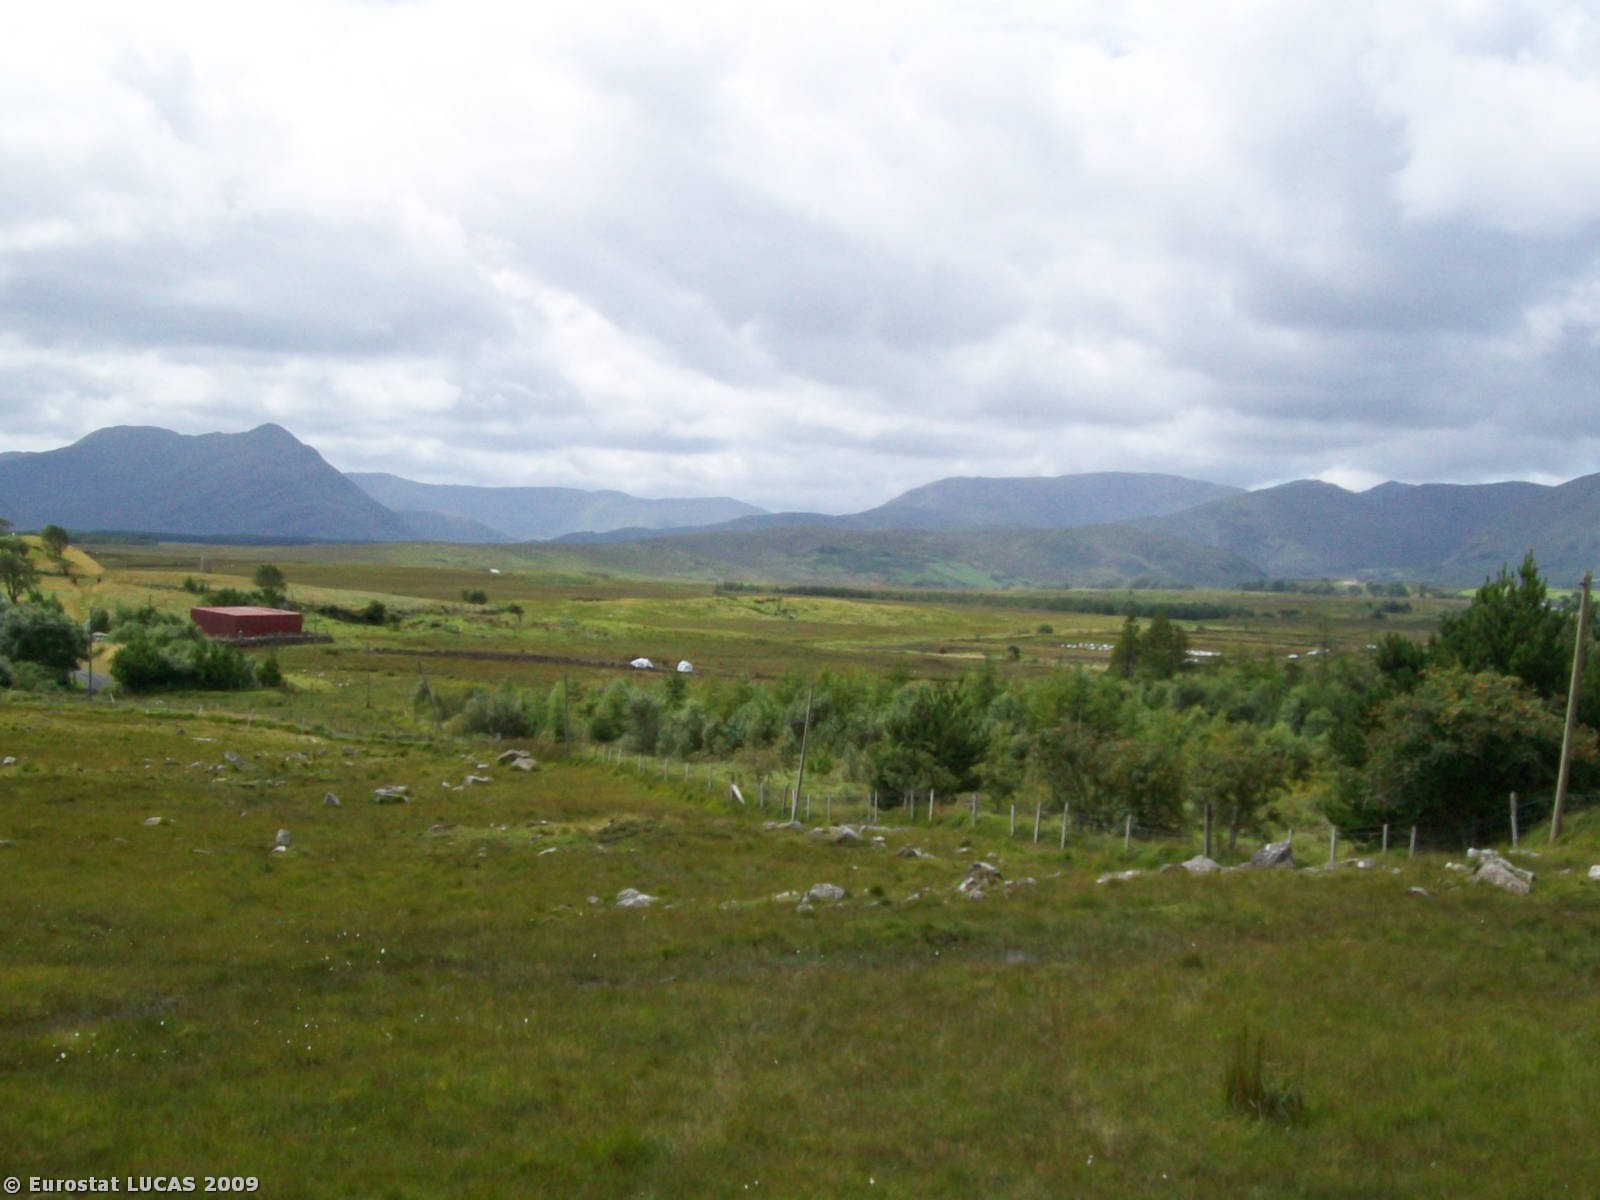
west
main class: Grassland
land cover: Grassland without tree/shrub cover
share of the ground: > 75 %
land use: Agriculture (excluding fallow land and kitchen gardens)
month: July
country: IE
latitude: 53.6955
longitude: -9.5443
